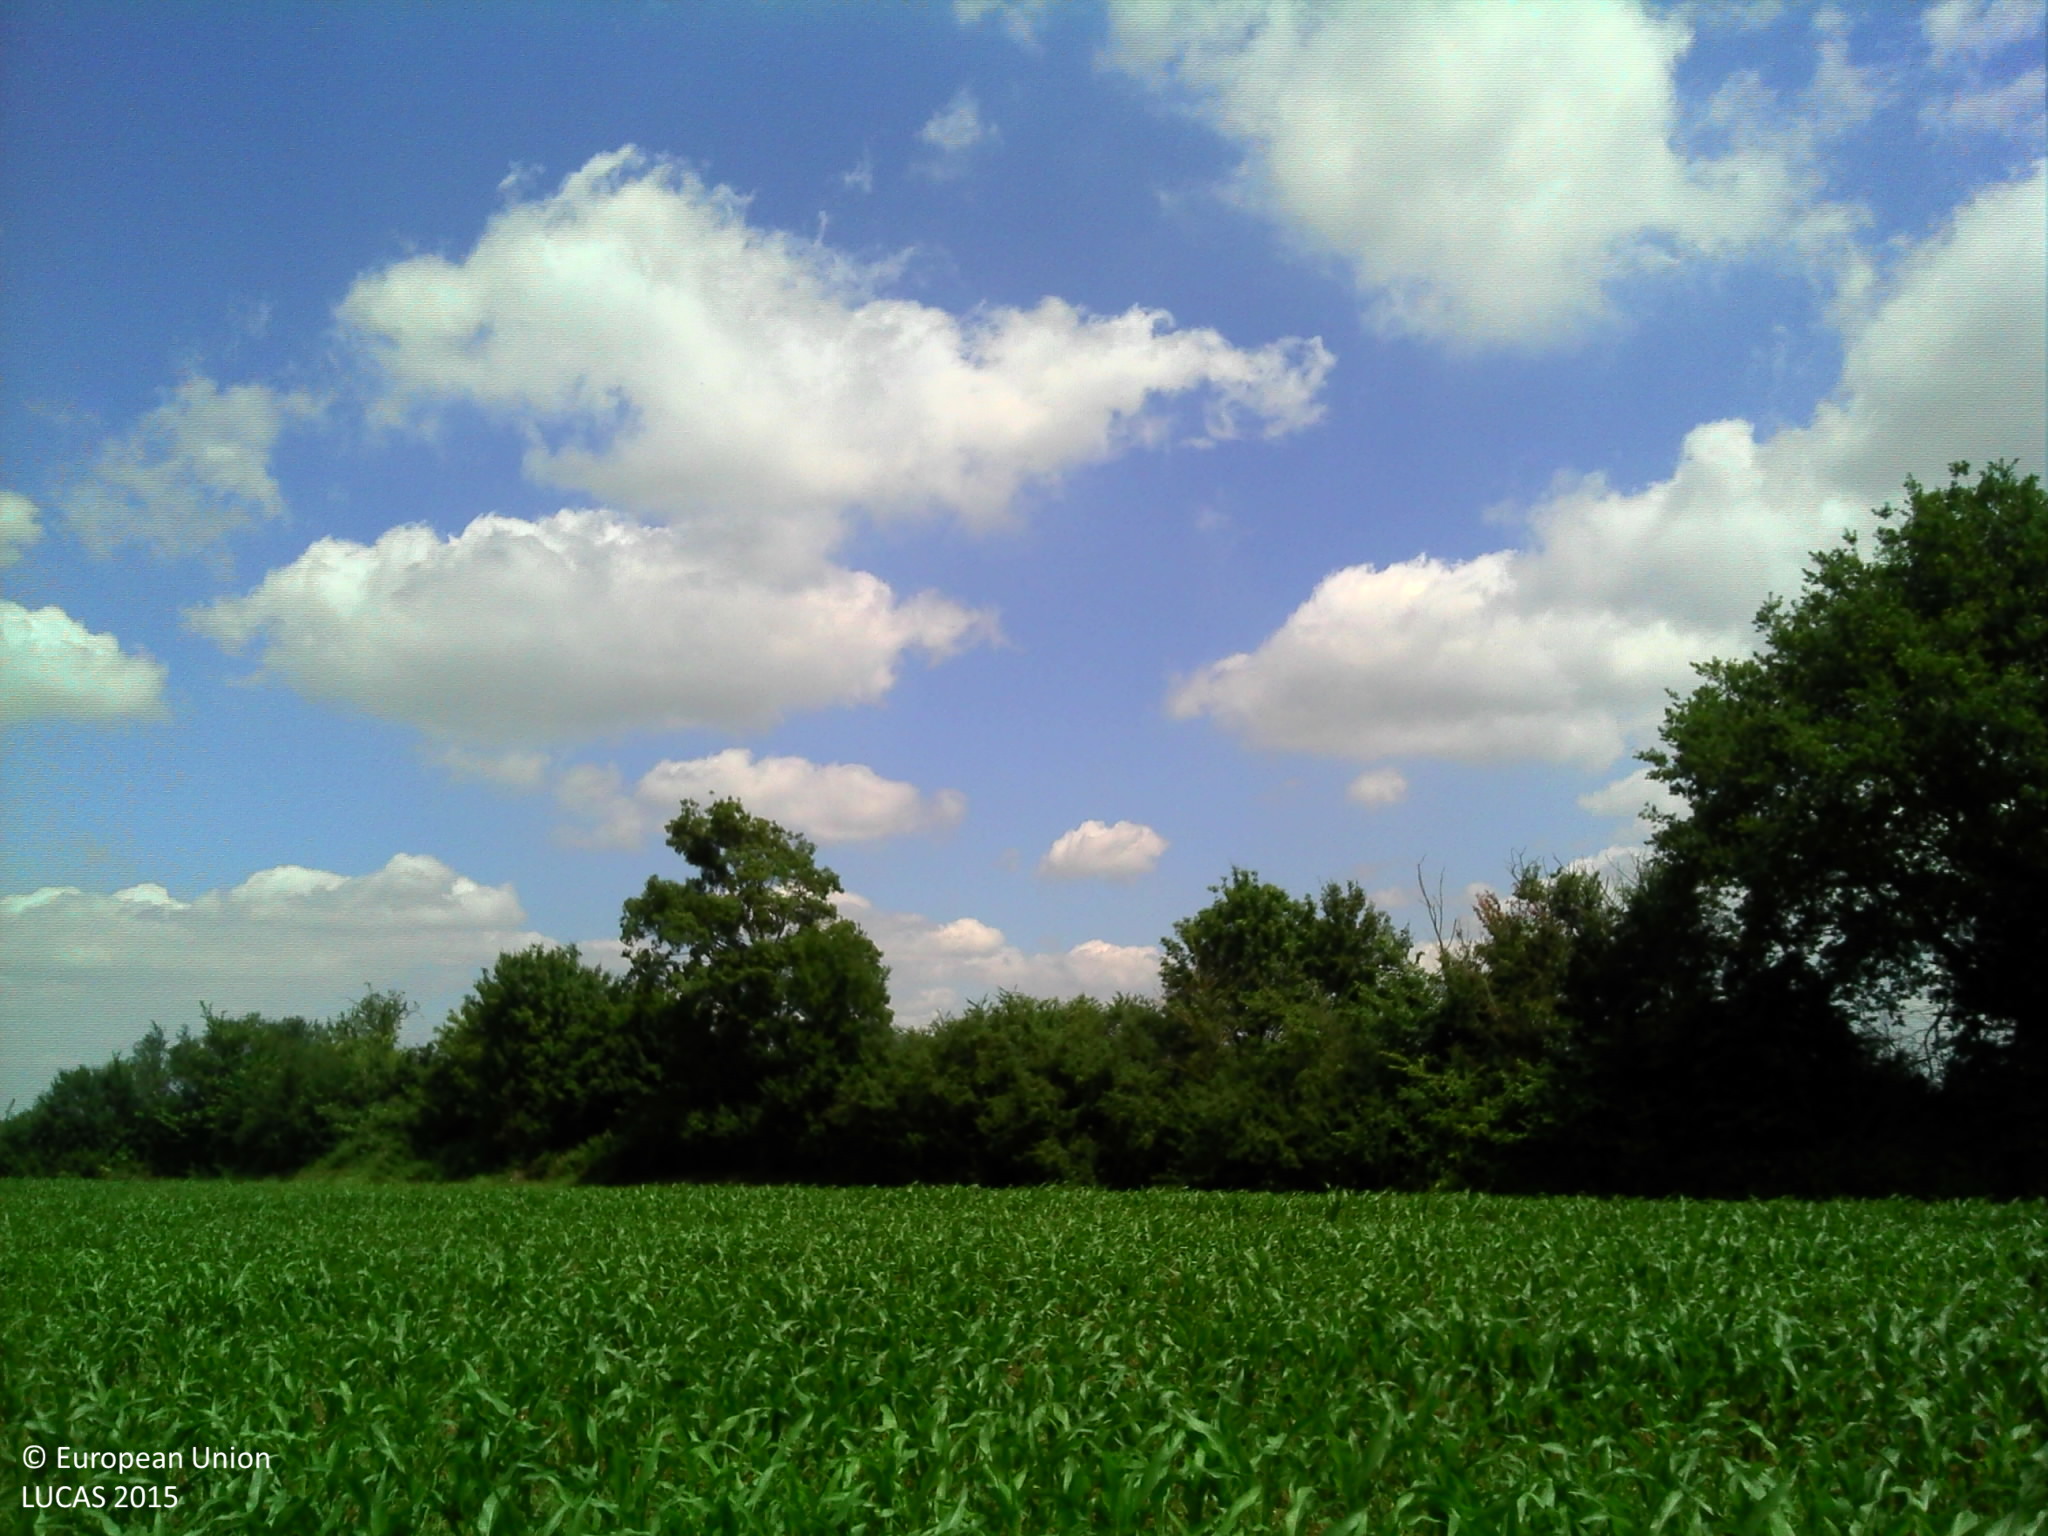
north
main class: Cropland
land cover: Maize
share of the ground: 25 - 50 %
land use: Agriculture (excluding fallow land and kitchen gardens)
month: June
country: FR
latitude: 48.2091
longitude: 0.2715
